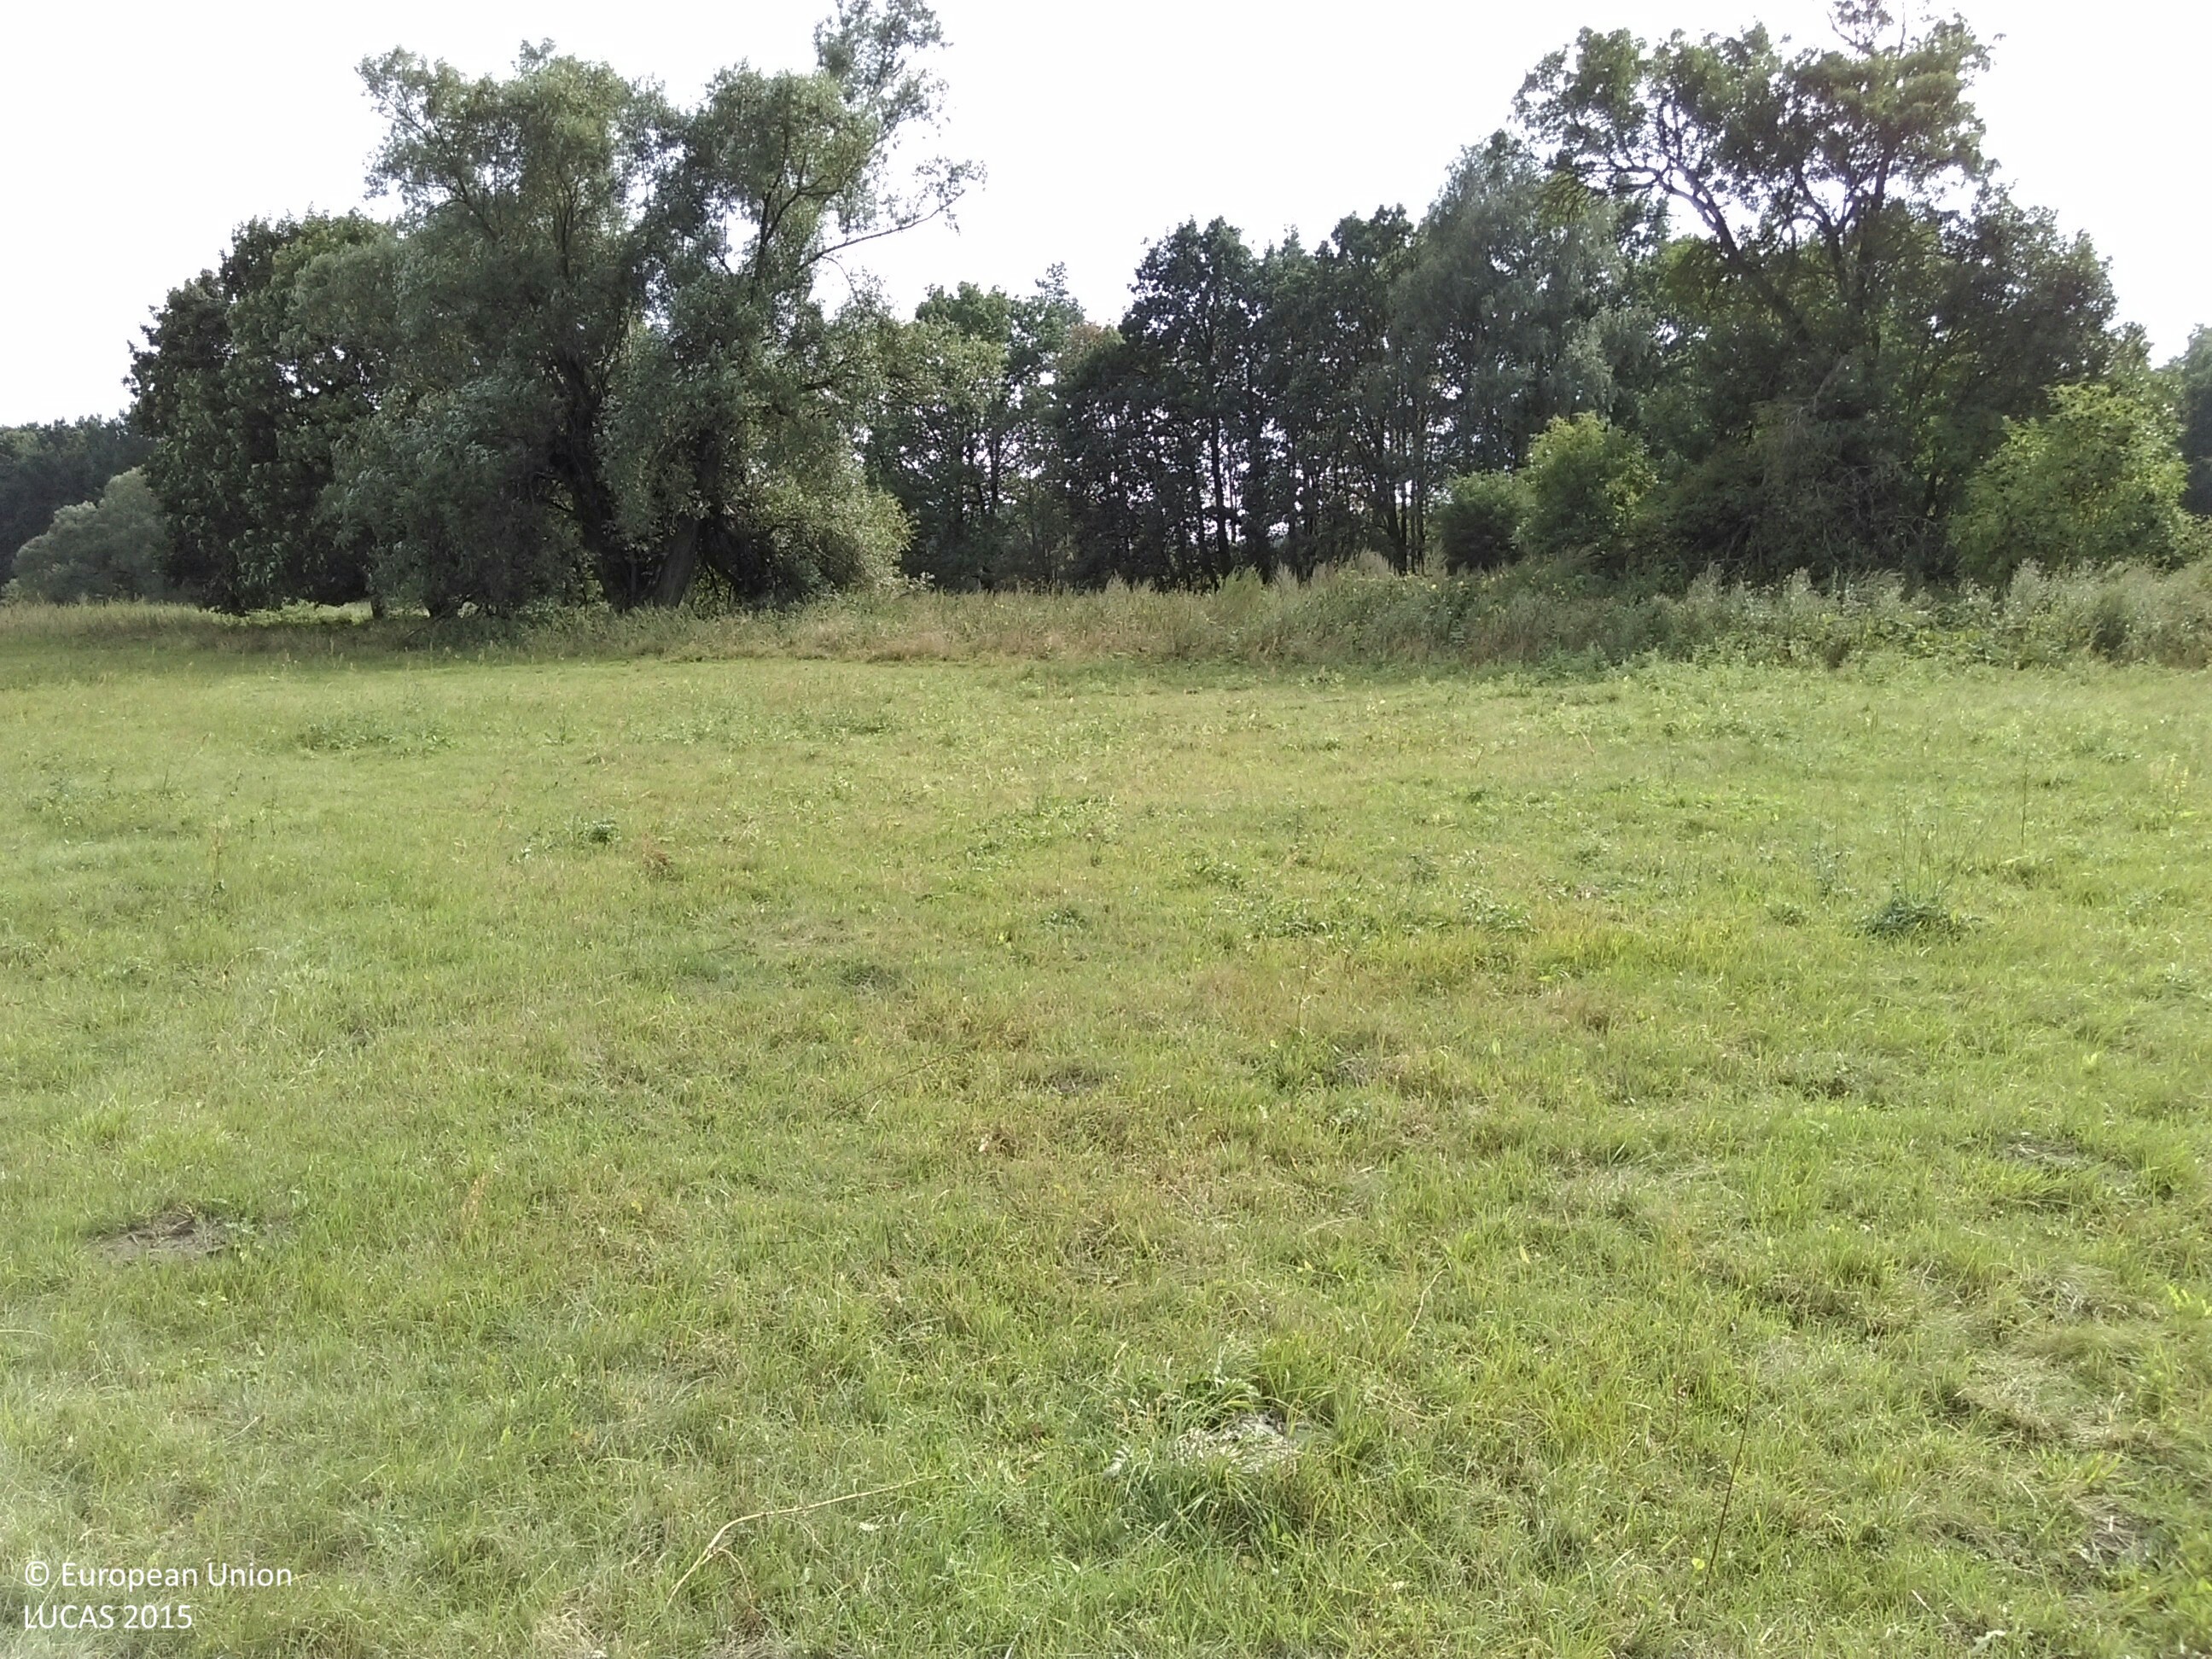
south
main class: Grassland
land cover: Grassland without tree/shrub cover
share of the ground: > 75 %
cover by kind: herbaceous plants 100 %
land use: Agriculture (excluding fallow land and kitchen gardens)
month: September
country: PL
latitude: 51.8864
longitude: 15.5689
